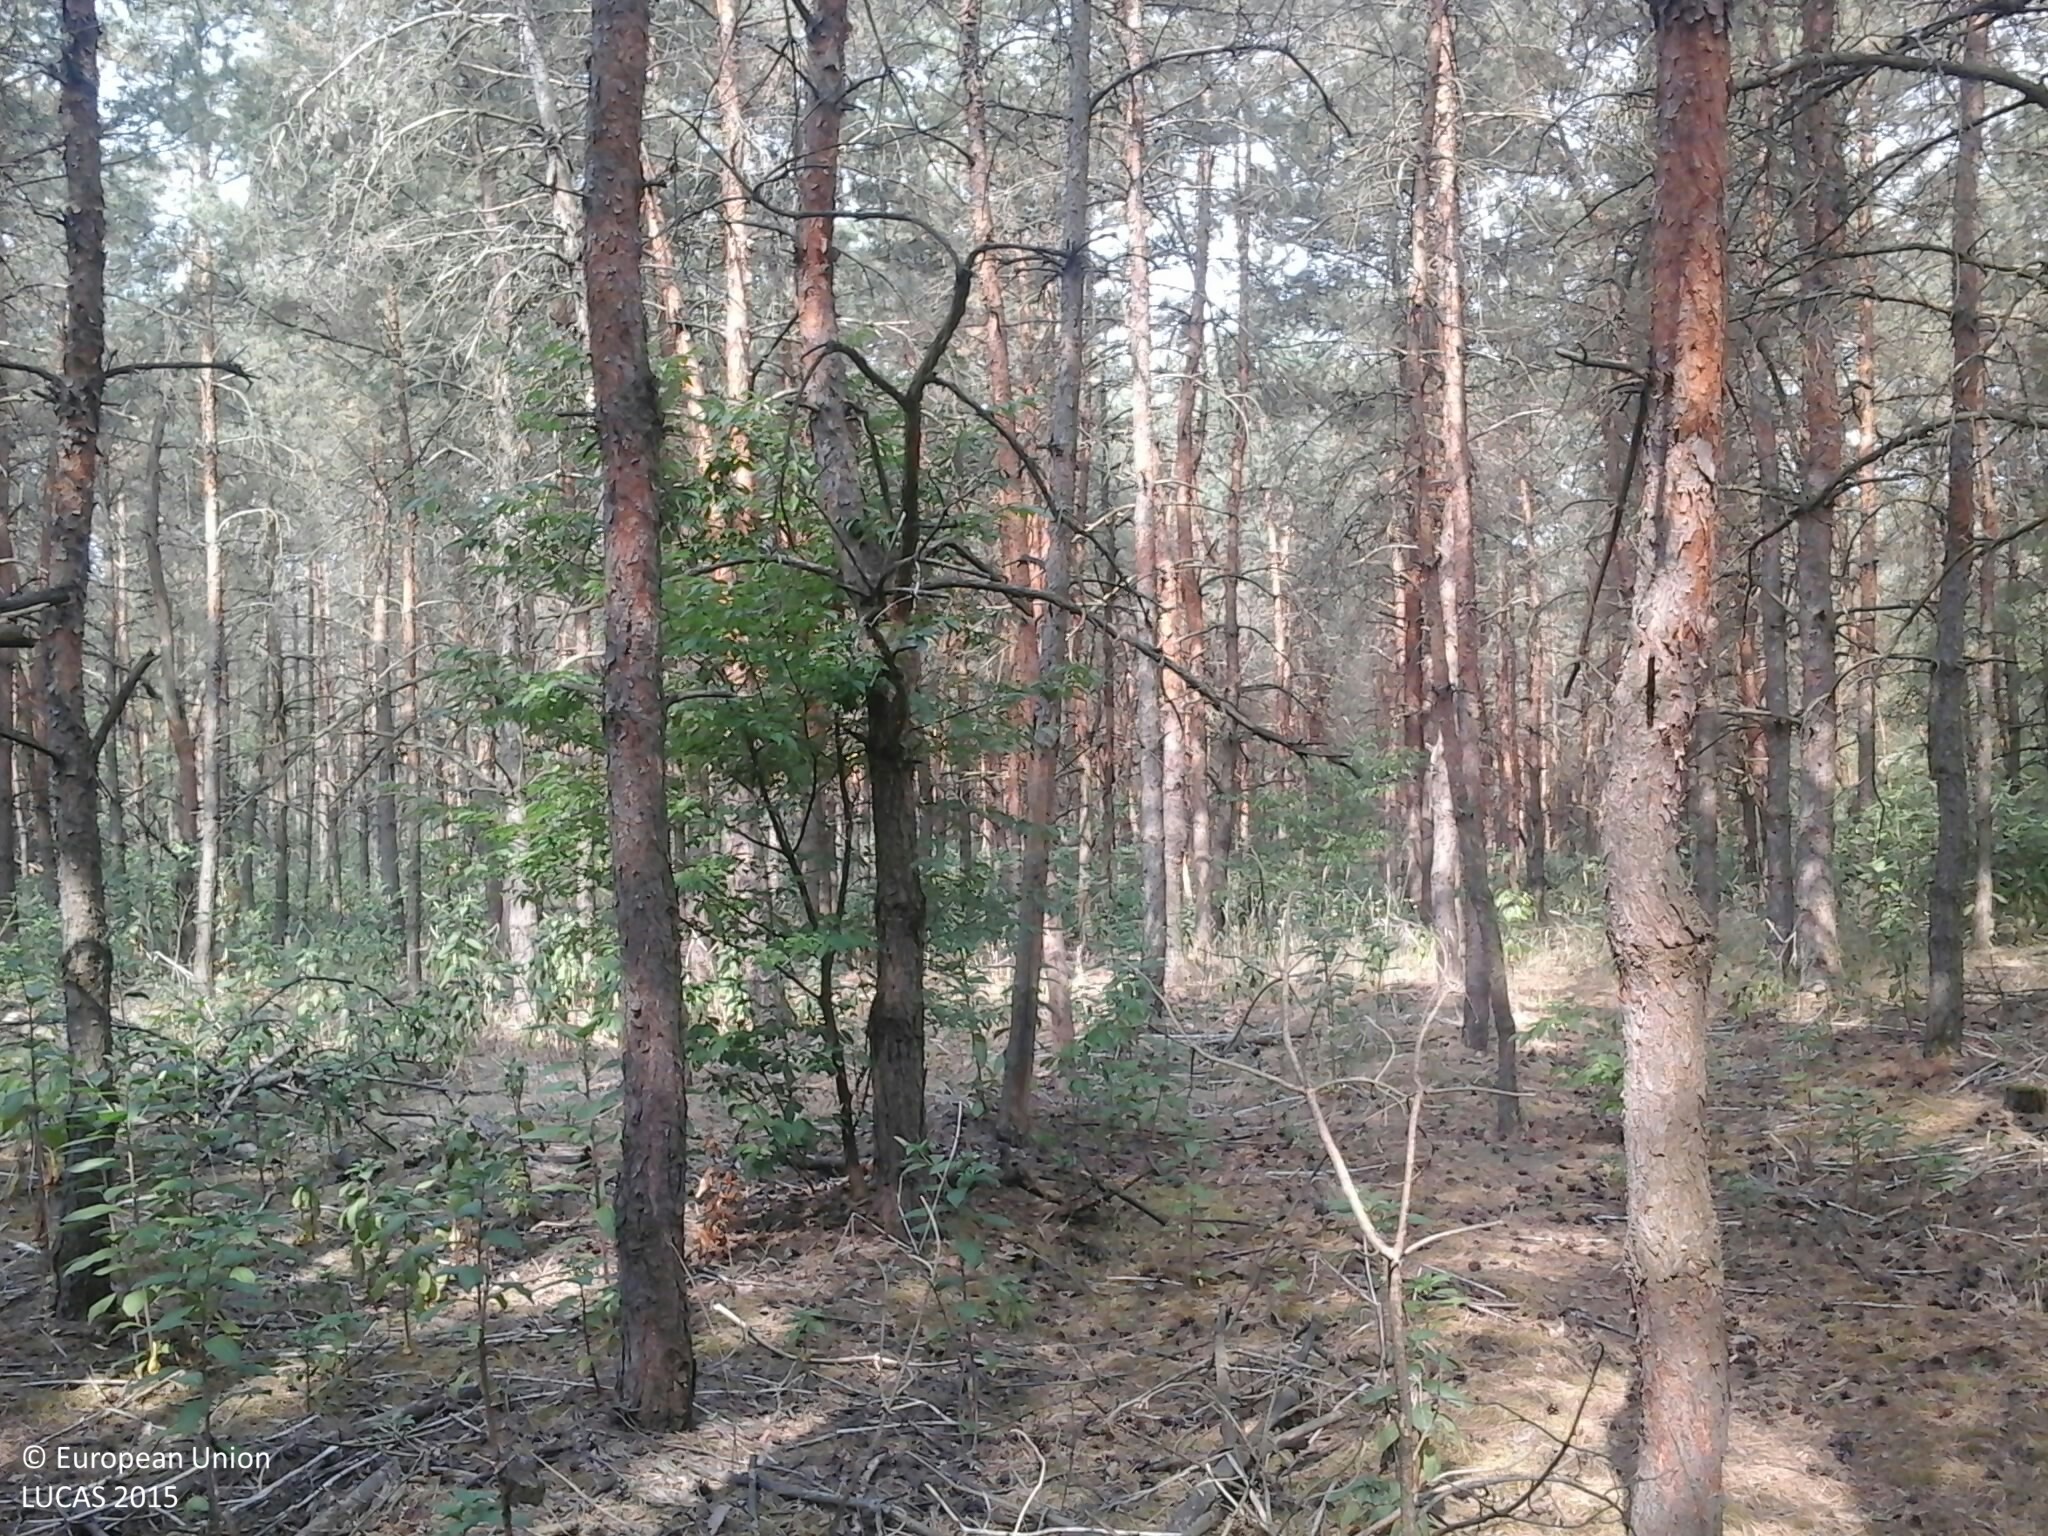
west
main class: Woodland
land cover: Pine dominated mixed woodland
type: hemiboreal forest and nemoral coniferous forest and mixed broadleaved-coniferous forest
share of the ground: > 75 %
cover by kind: coniferous forest trees 70 %, broadleaved forest trees 25 %, lichens and mosses 5 %
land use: Forestry
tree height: > 5 m
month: July
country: HU
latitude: 47.7221
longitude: 22.2255
